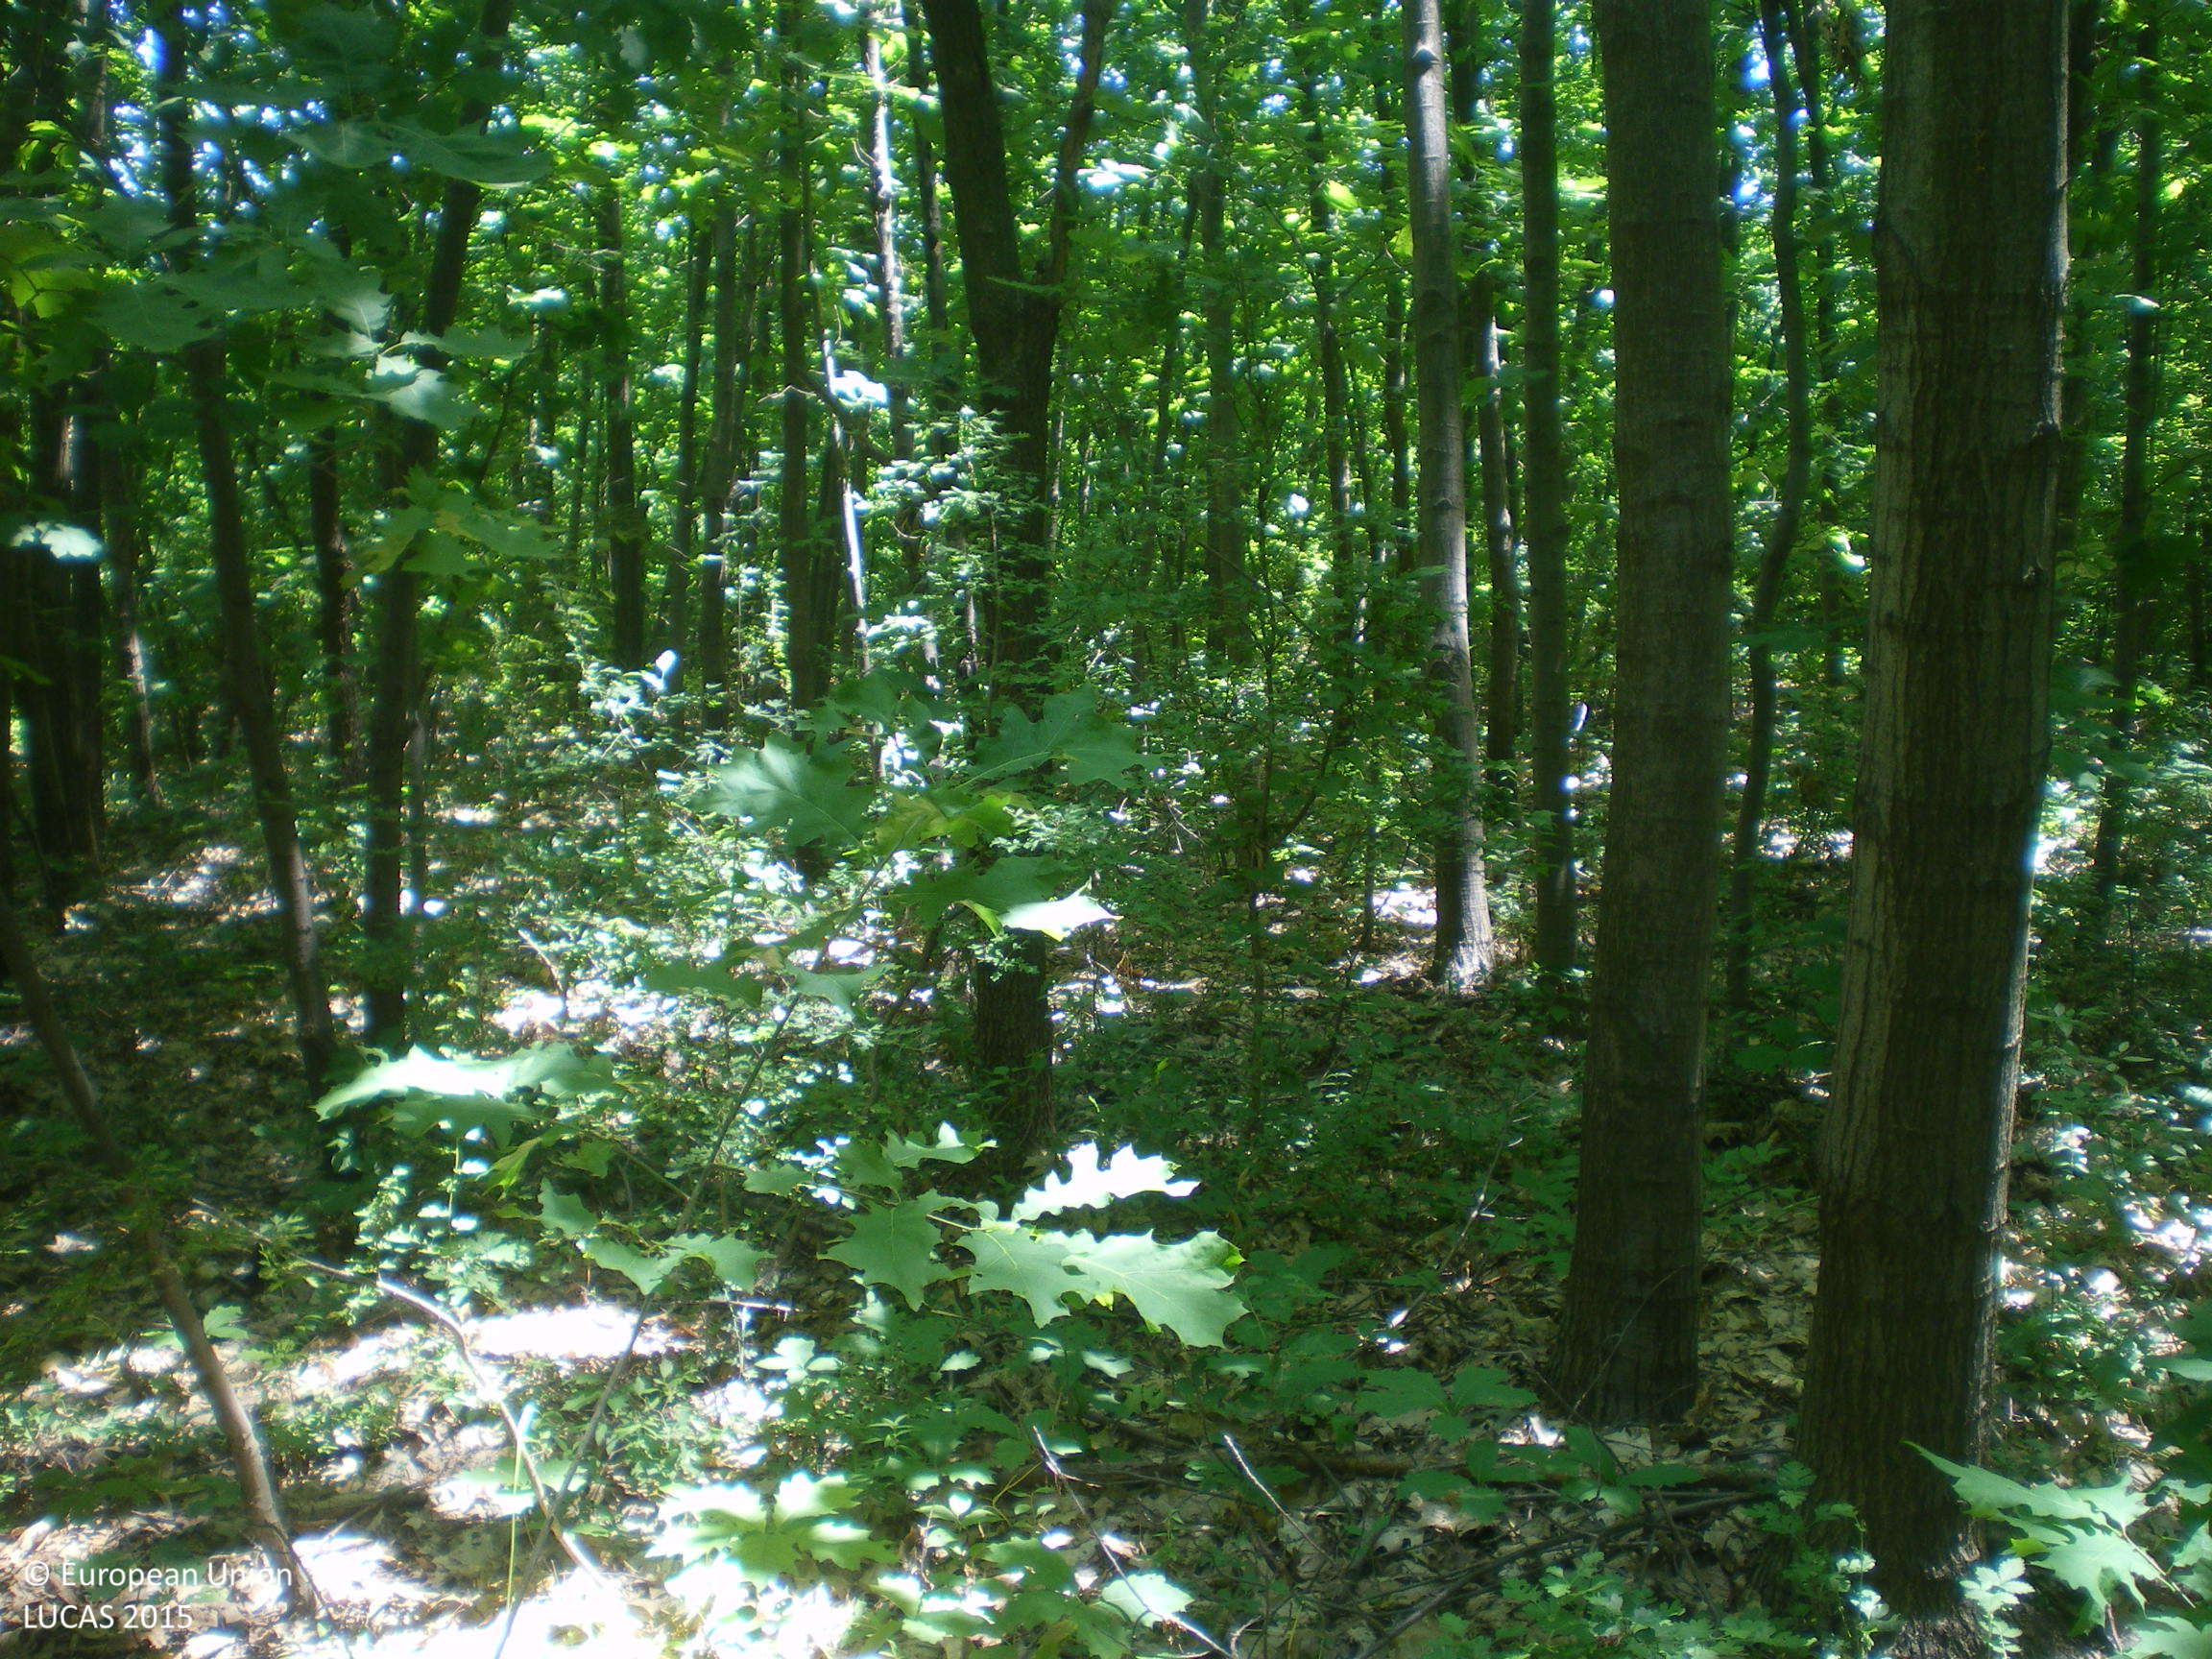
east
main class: Woodland
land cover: Broadleaved woodland
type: mesophytic deciduous forest
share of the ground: > 75 %
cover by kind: broadleaved forest trees 95 %, herbaceous plants 5 %
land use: Forestry
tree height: > 5 m
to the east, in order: Broadleaved woodland; Tracks; Broadleaved woodland
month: June
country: BG
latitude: 42.2268
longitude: 25.1194
